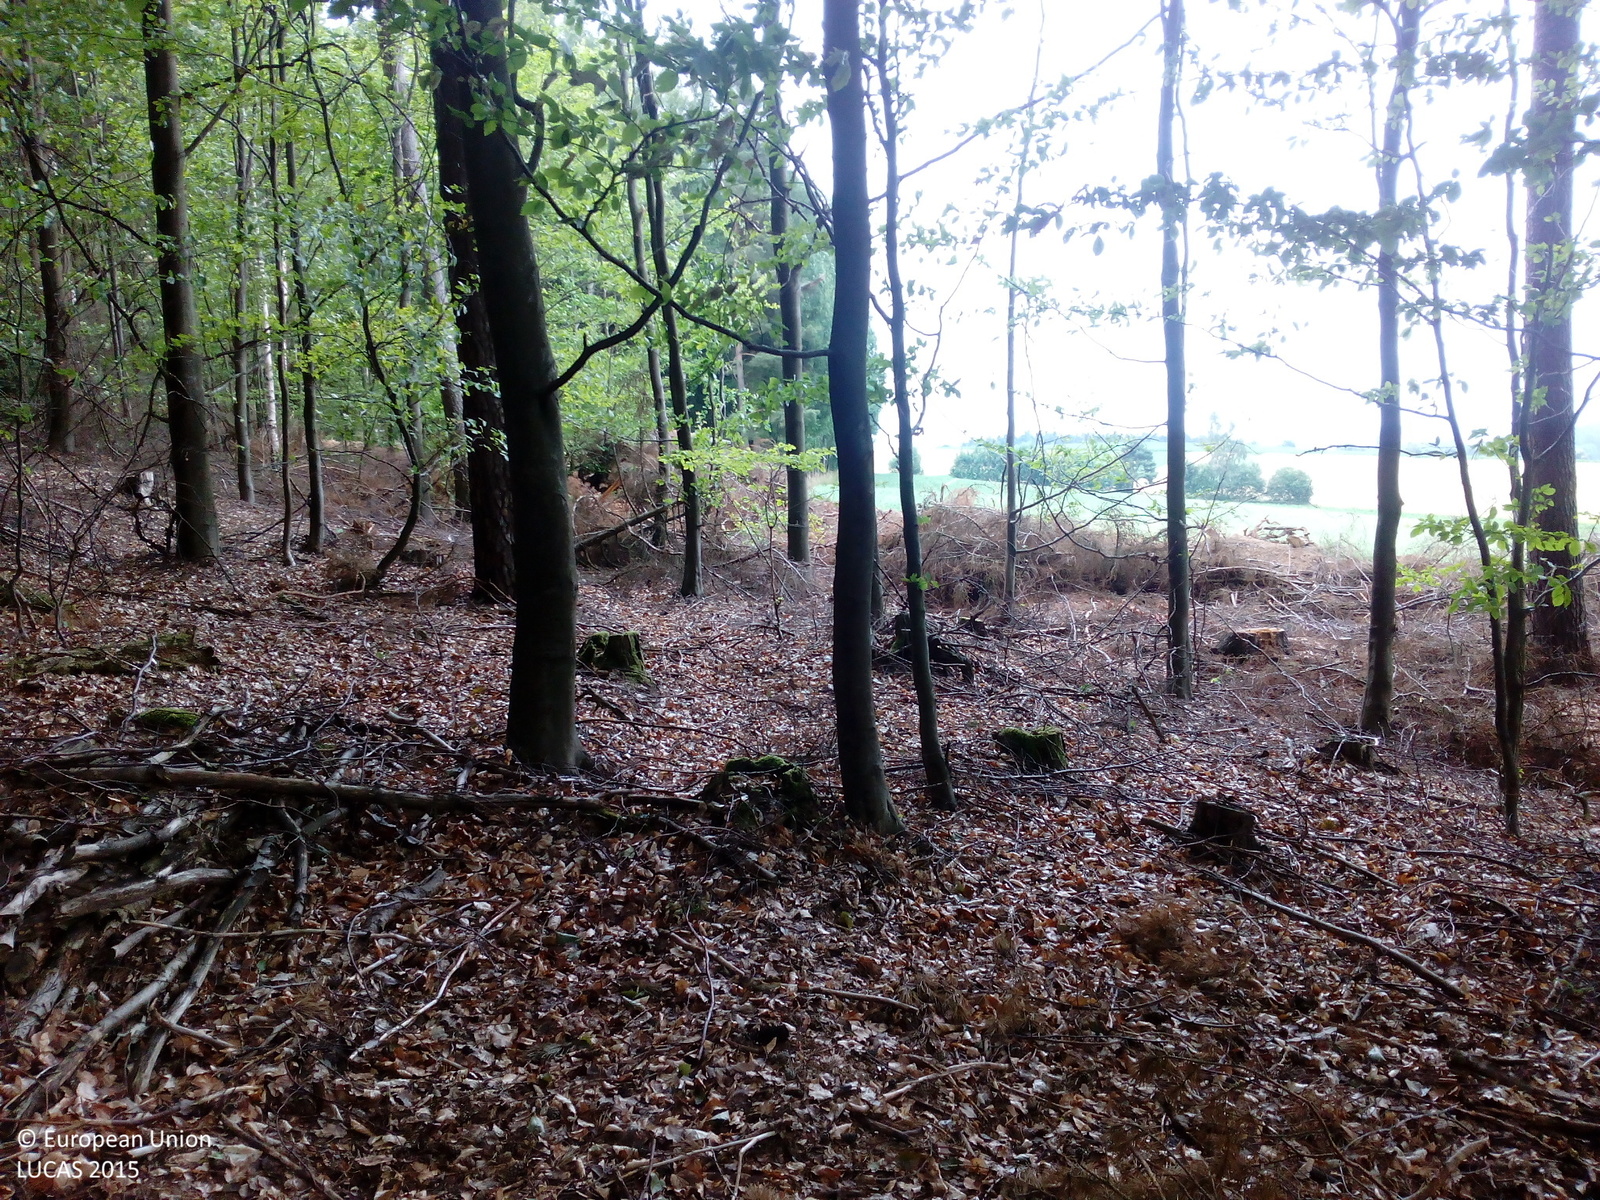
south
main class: Woodland
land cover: Broadleaved woodland
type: mesophytic deciduous forest
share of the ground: > 75 %
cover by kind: broadleaved forest trees 80 %, unconsolidated bare surface 10 %, coniferous forest trees 5 %, herbaceous plants 5 %
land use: Forestry
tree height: > 5 m
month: July
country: DE
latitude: 49.6368
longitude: 12.4228
